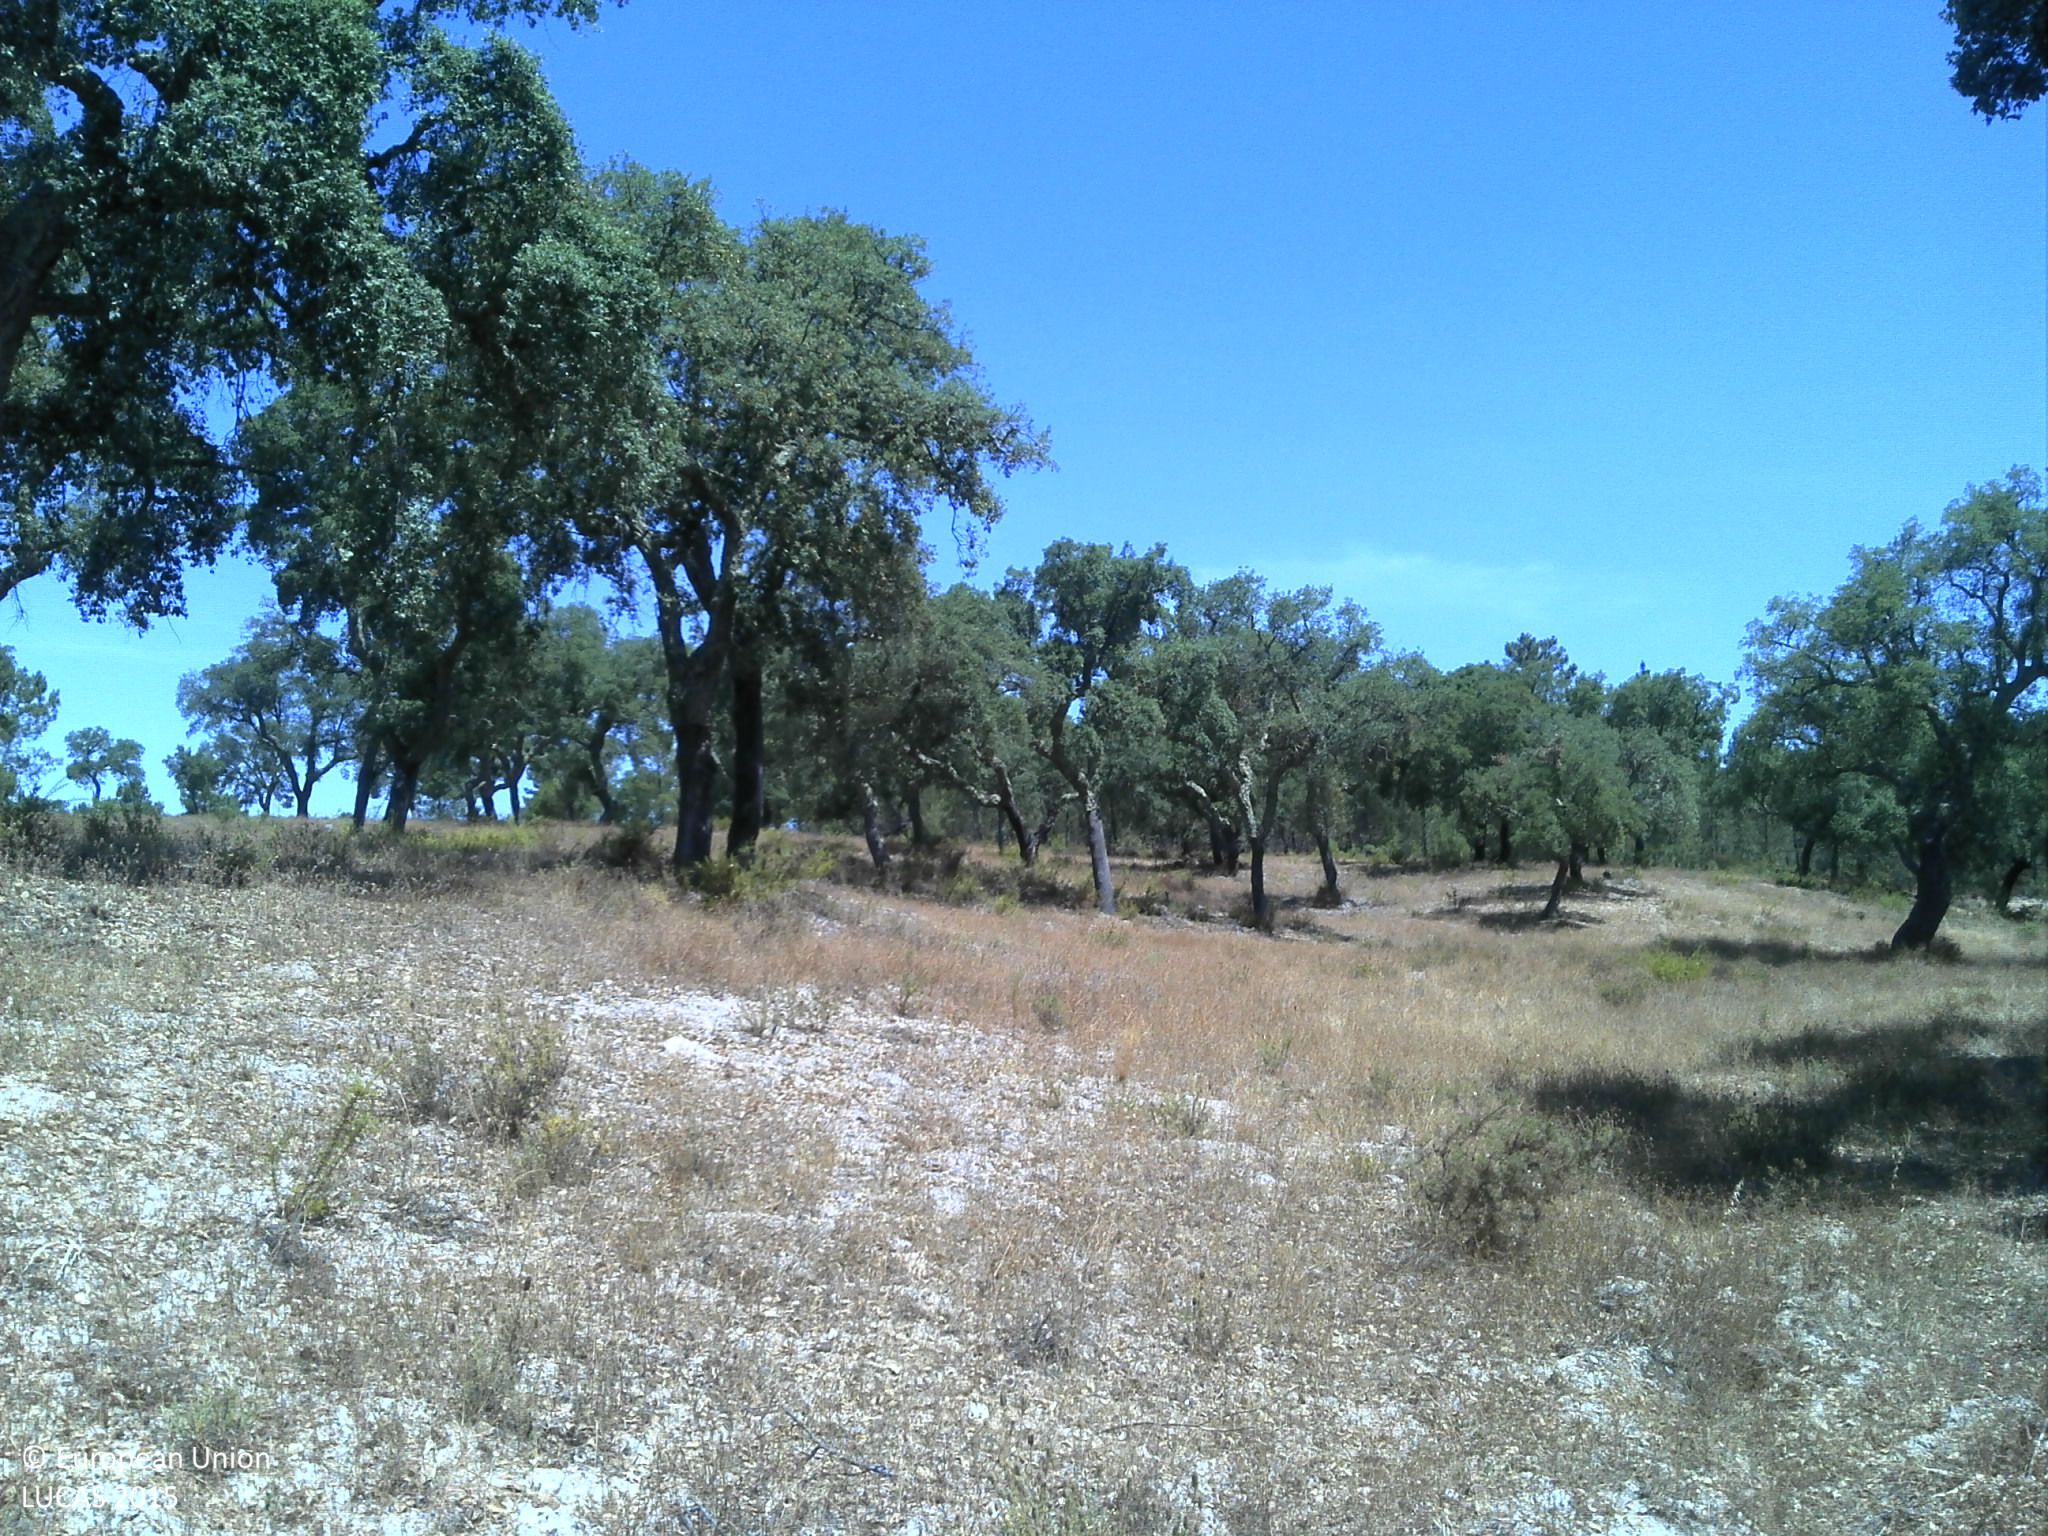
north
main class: Woodland
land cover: Broadleaved woodland
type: broadleaved evergreen forest
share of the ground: 10 - 25 %
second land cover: Grassland without tree/shrub cover
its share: 25 - 50 %
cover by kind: unconsolidated bare surface 55 %, herbaceous plants 25 %, broadleaved forest trees 15 %, shrubs 5 %
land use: Forestry
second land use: Agriculture (excluding fallow land and kitchen gardens)
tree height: > 5 m
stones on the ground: < 10 %
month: July
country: PT
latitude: 39.2130
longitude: -8.2075
